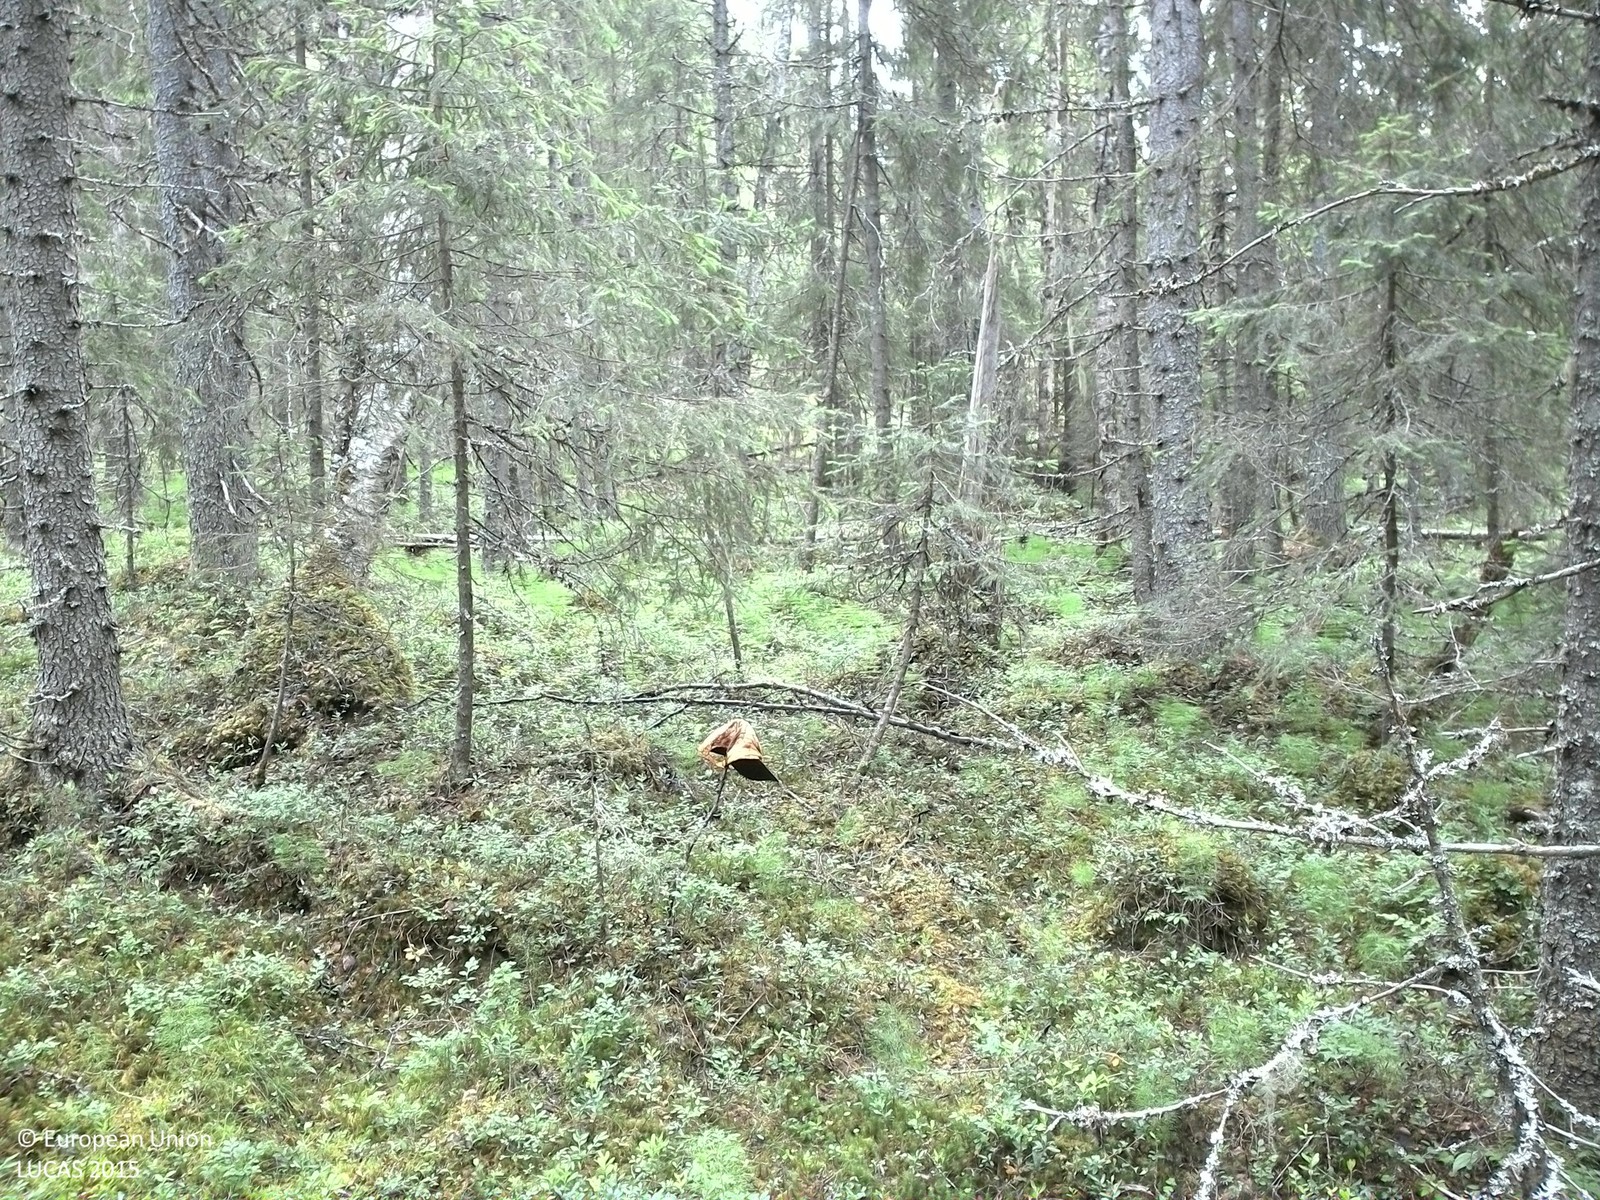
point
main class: Woodland
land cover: Spruce dominated coniferous woodland
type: boreal forest
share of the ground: > 75 %
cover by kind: coniferous forest trees 75 %, shrubs 15 %, broadleaved forest trees 5 %, herbaceous plants 5 %
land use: Forestry
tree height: > 5 m
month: July
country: SE
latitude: 63.5529
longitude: 18.4885
